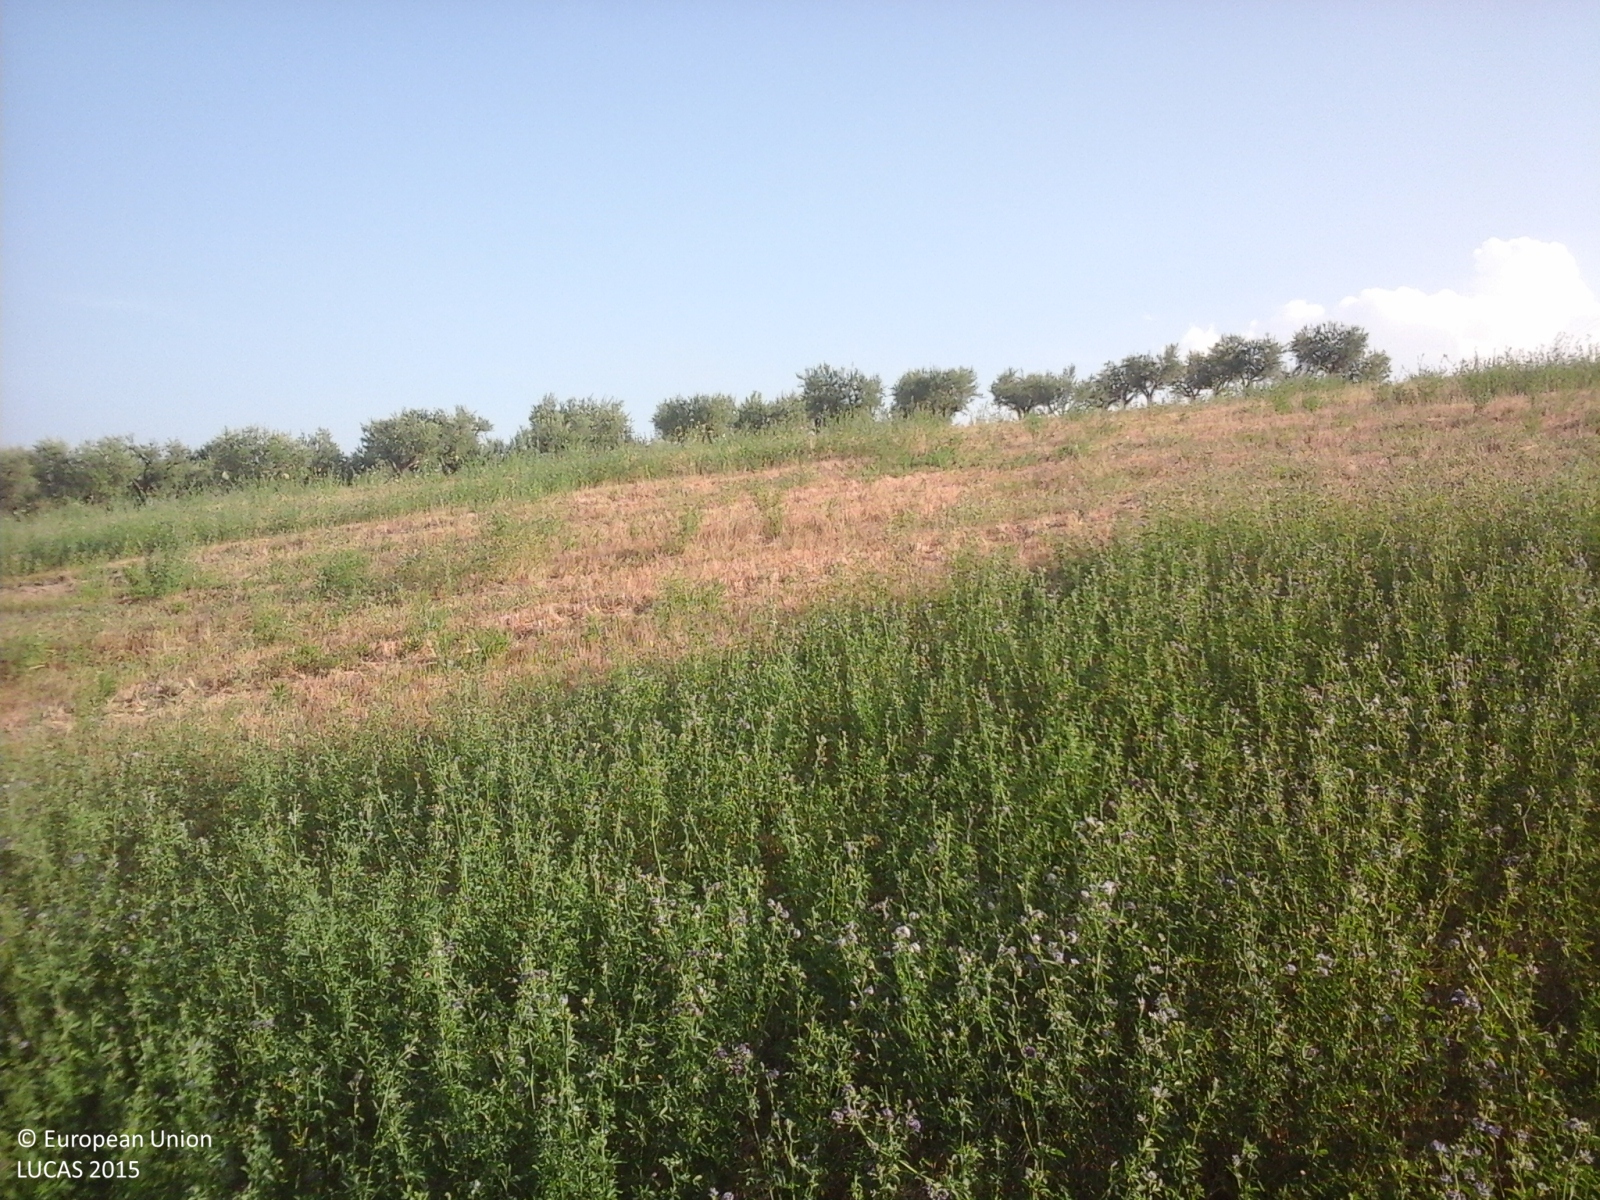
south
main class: Cropland
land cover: Lucerne
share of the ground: > 75 %
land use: Agriculture (excluding fallow land and kitchen gardens)
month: July
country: IT
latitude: 43.1753
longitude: 13.3986
